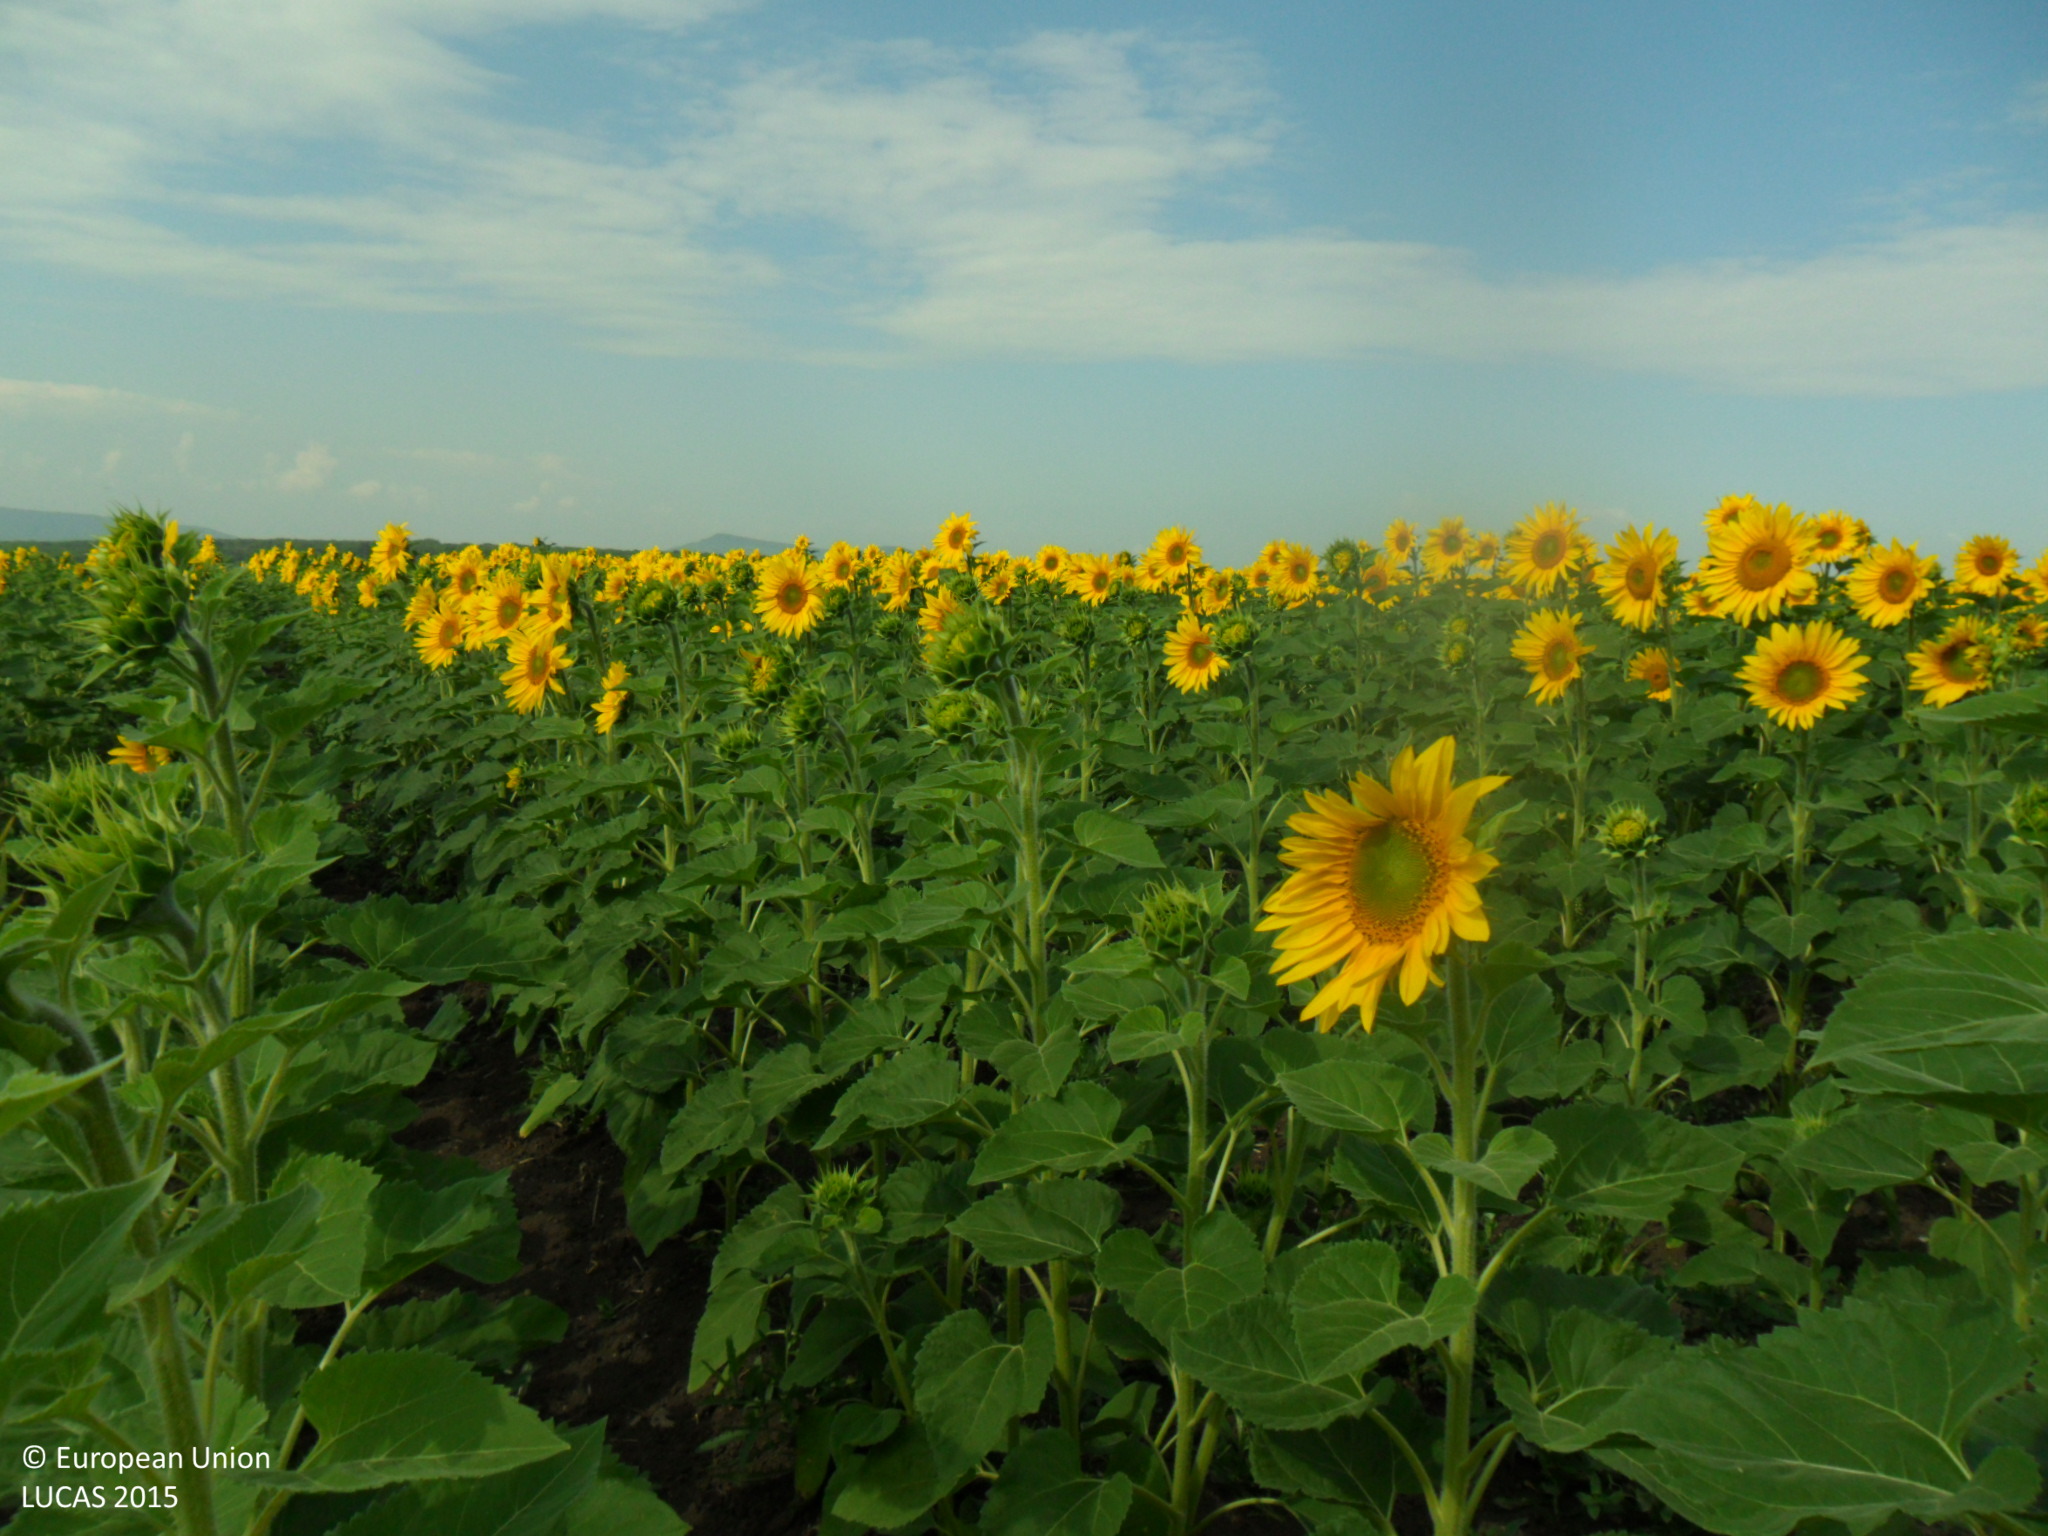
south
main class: Cropland
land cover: Sunflower
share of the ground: > 75 %
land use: Agriculture (excluding fallow land and kitchen gardens)
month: June
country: BG
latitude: 43.3721
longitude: 26.8089
